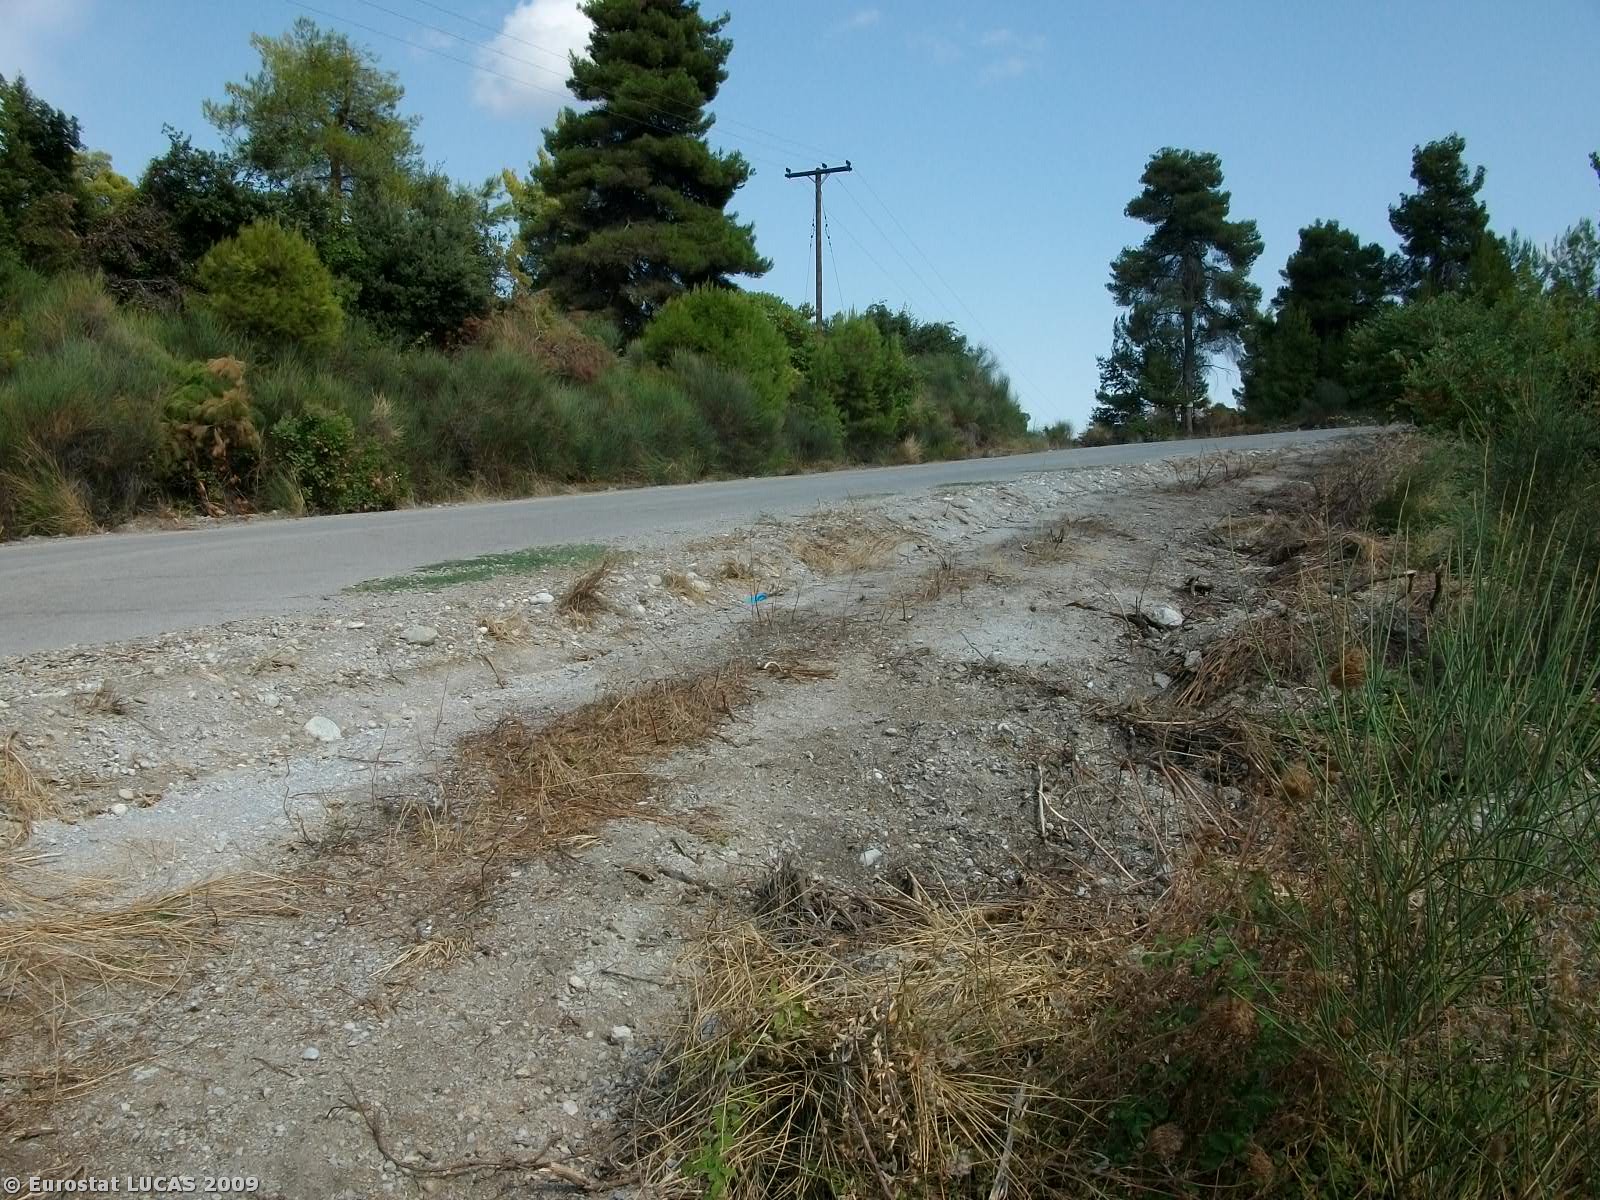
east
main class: Shrubland
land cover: Shrubland without tree cover
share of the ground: 25 - 50 %
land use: Fallow land
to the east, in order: Shrubland without tree cover; Paved roads, cycling and walking lanes; Ditches and canals; Electric lines; Shrubland with sparse tree cover; Tracks; Coniferous woodland; Tracks; Coniferous woodland; Tracks; Mixed woodland; Spontaneously vegetated surfaces
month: August
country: GR
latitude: 38.8995
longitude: 23.1668
